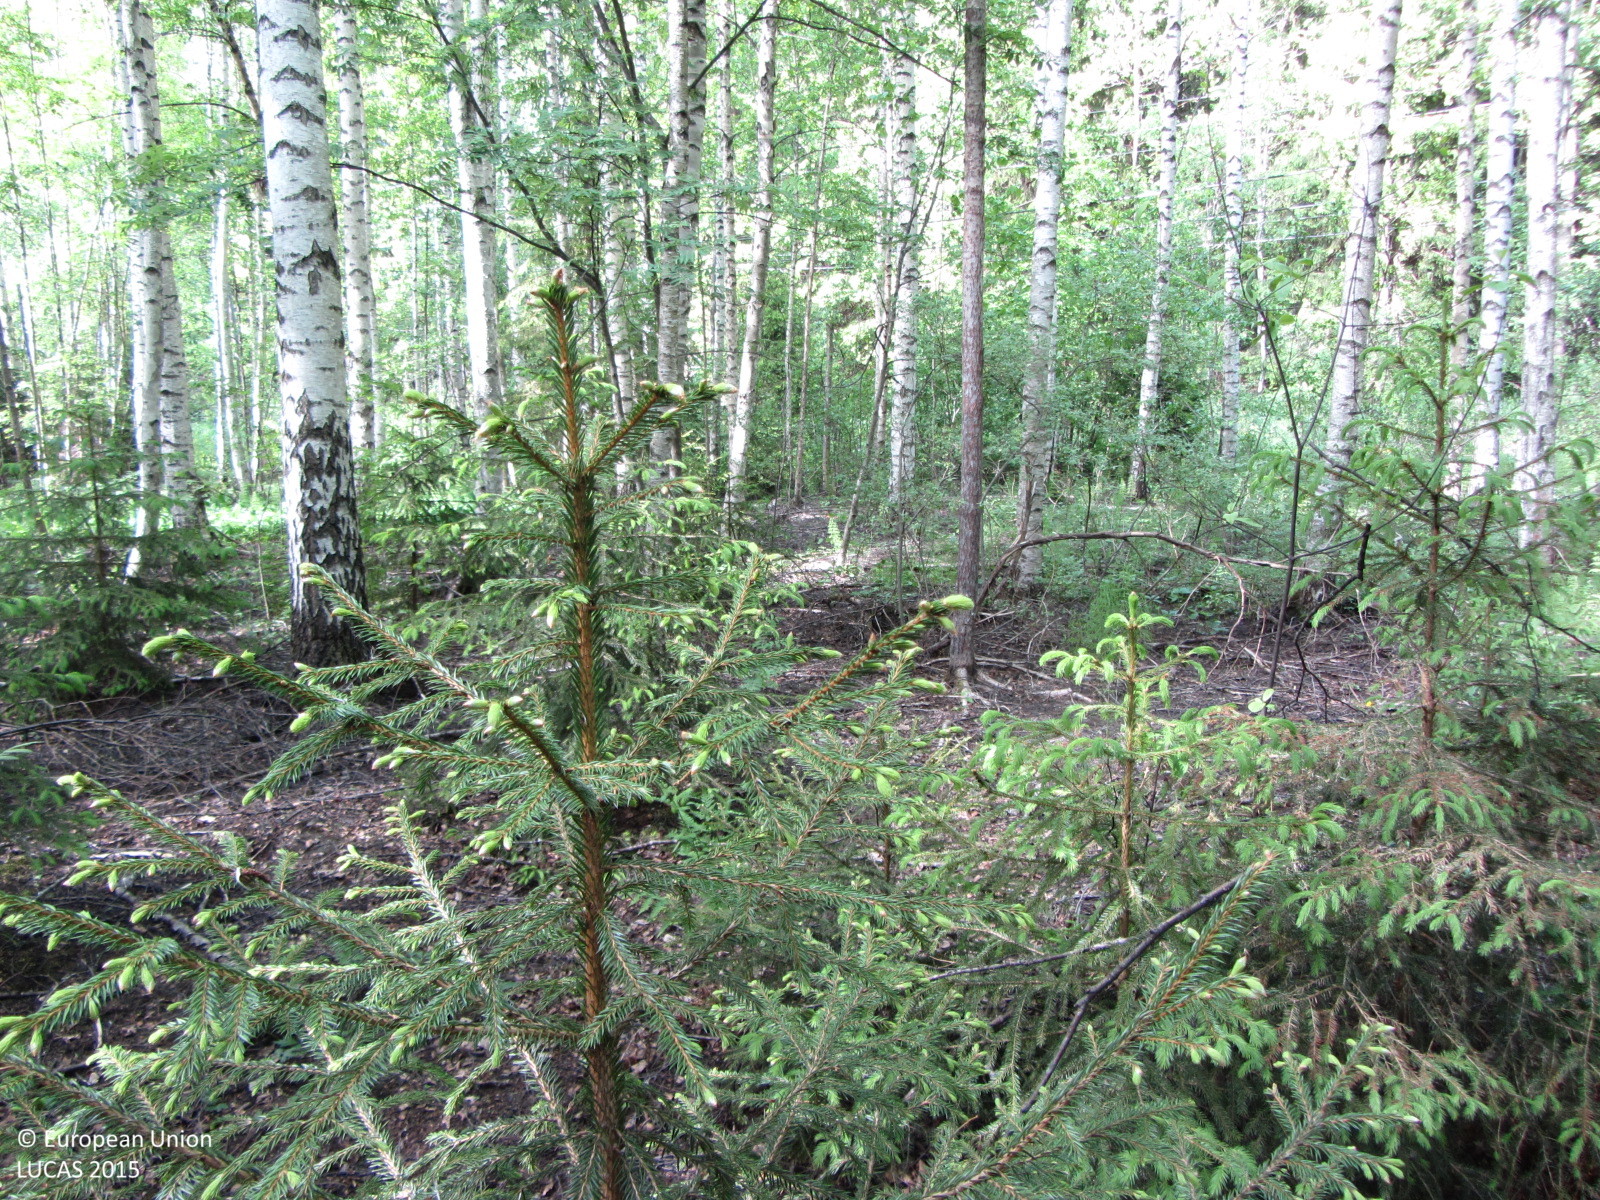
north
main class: Woodland
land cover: Broadleaved woodland
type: boreal forest
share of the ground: > 75 %
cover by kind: broadleaved forest trees 85 %, coniferous forest trees 10 %, herbaceous plants 5 %
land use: Forestry
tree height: > 5 m
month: June
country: FI
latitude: 60.2937
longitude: 24.2680
